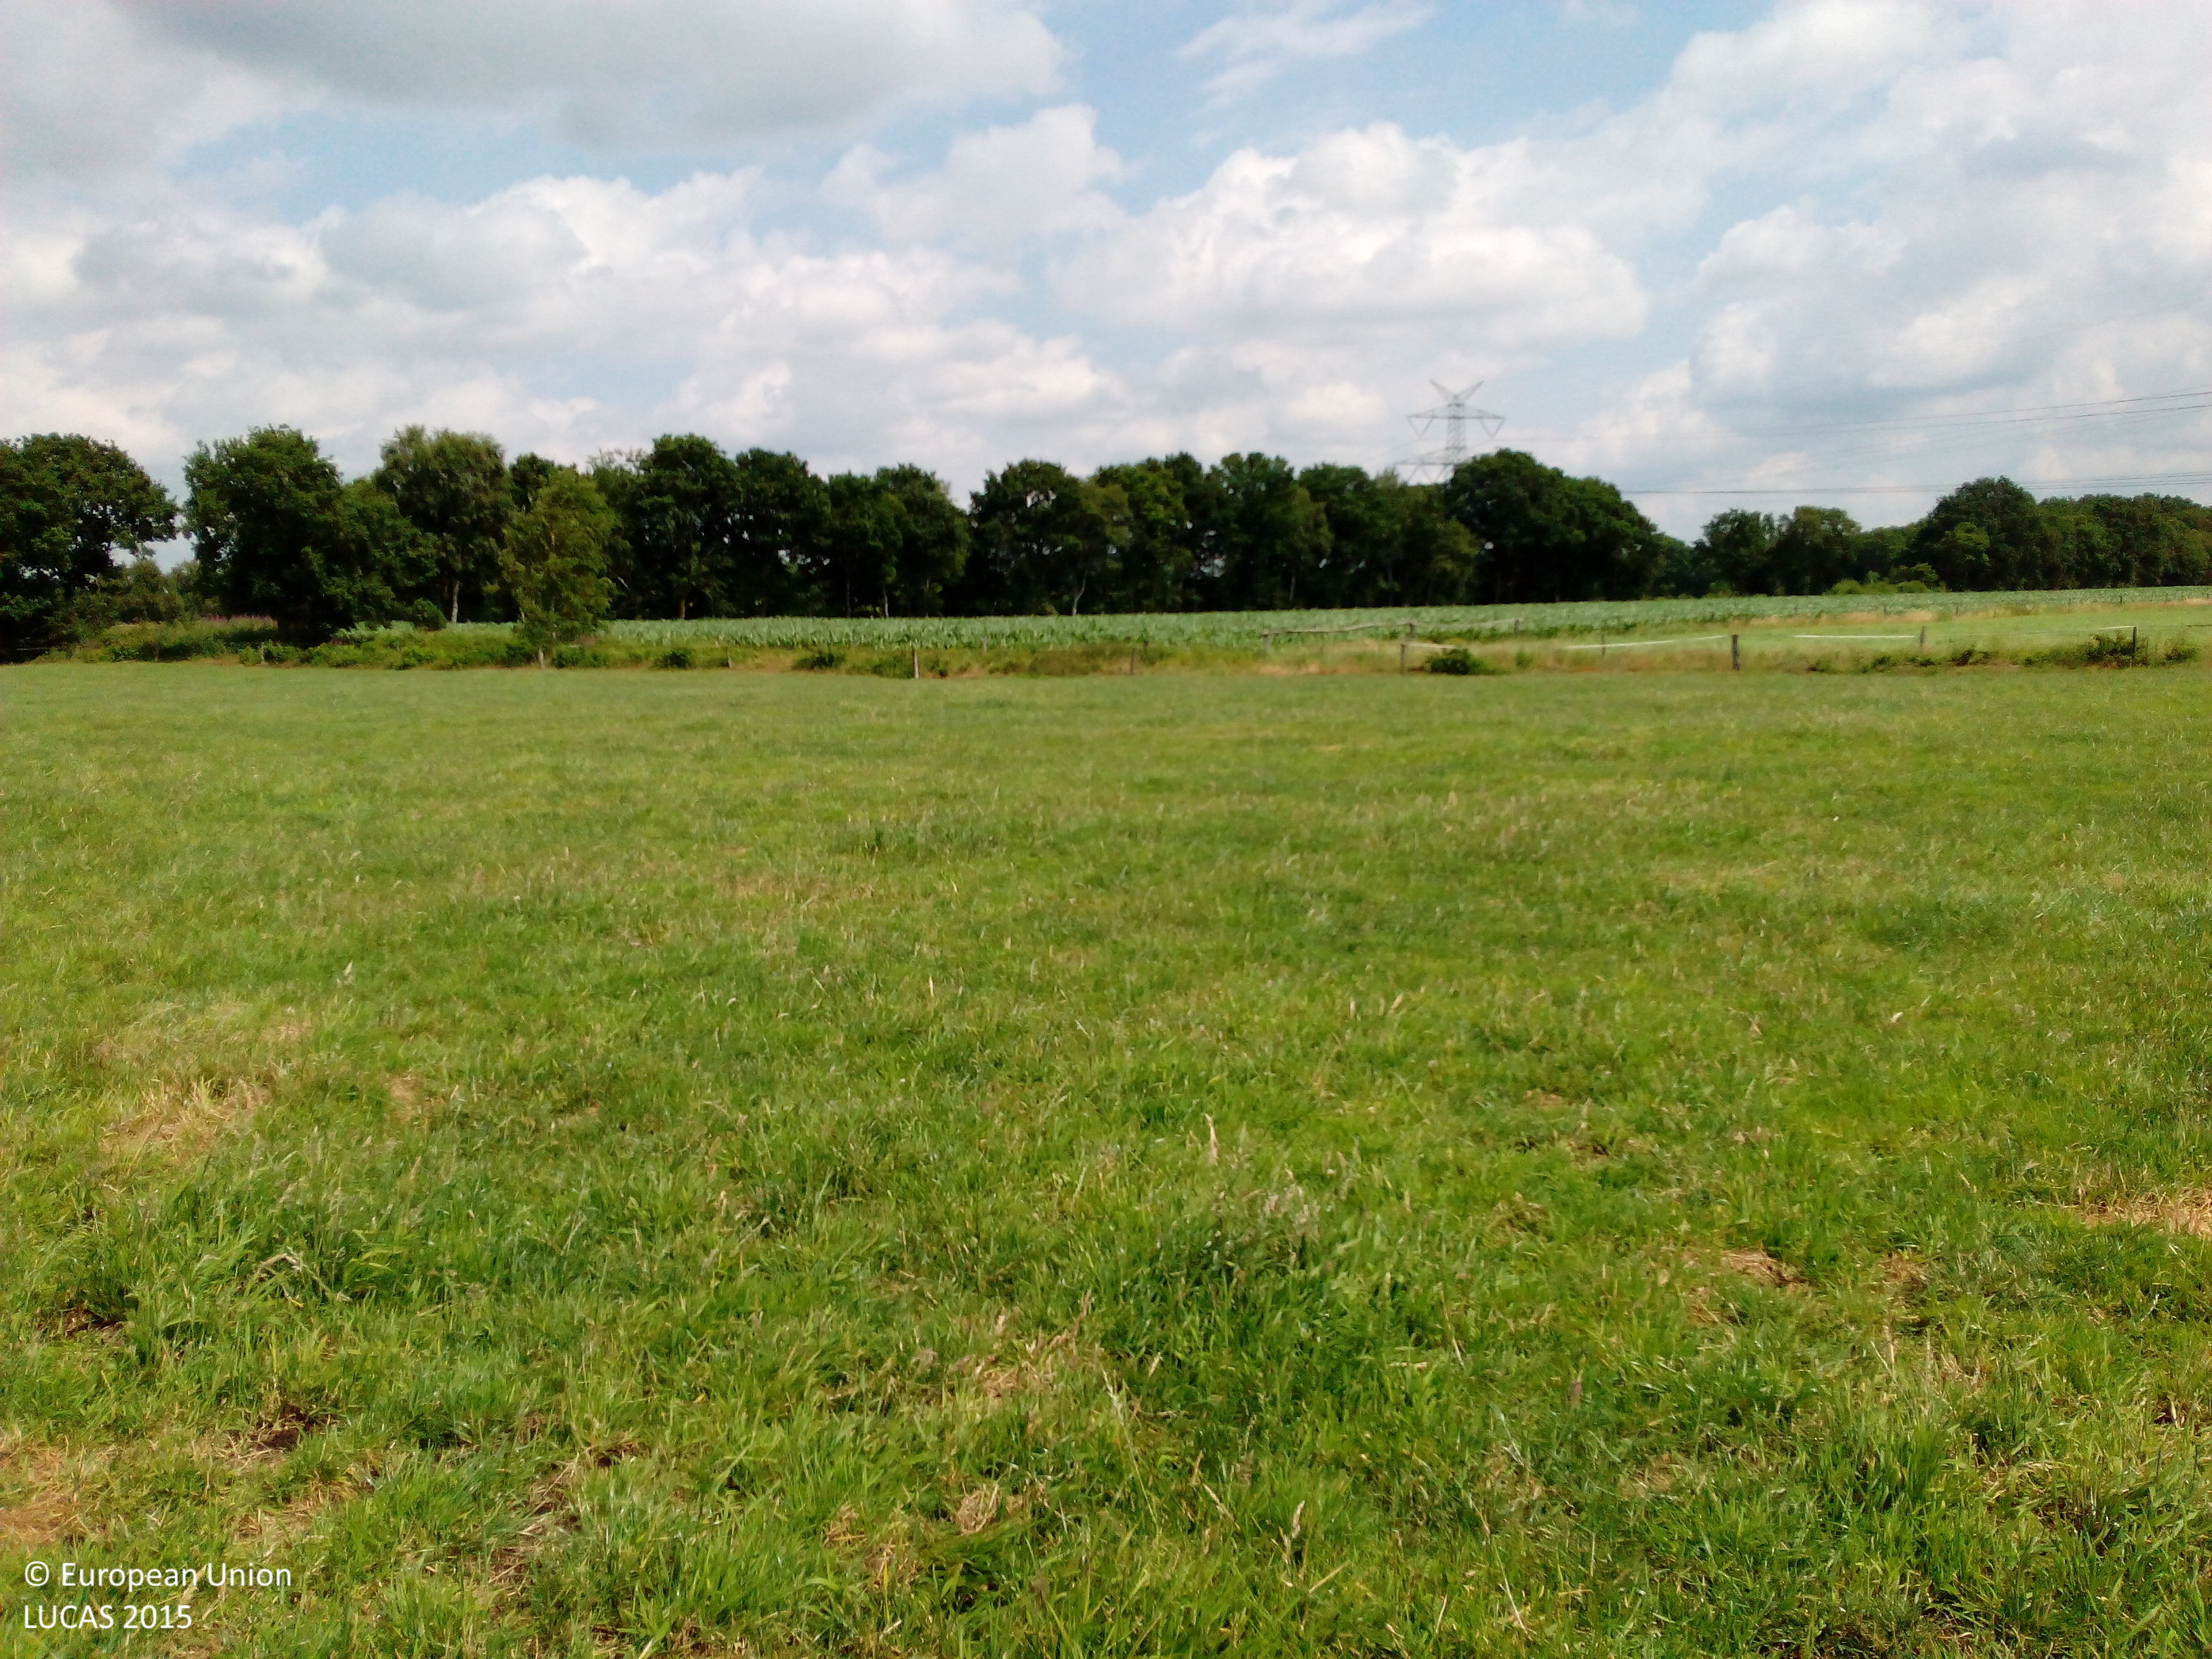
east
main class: Grassland
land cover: Grassland without tree/shrub cover
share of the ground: > 75 %
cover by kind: herbaceous plants 100 %
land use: Agriculture (excluding fallow land and kitchen gardens)
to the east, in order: Grassland without tree/shrub cover; Fences; Grass margins; Ditches and canals; Grass margins; Fences; Grassland without tree/shrub cover; Fences; Maize; Fences; Ditches and canals; Broadleaved woodland; Paved roads, cycling and walking lanes; Broadleaved woodland; Ditches and canals; Shruby margins; Grassland without tree/shrub cover; Fences; Grassland without tree/shrub cover; Maize
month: July
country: DE
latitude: 53.3115
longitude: 7.8844
